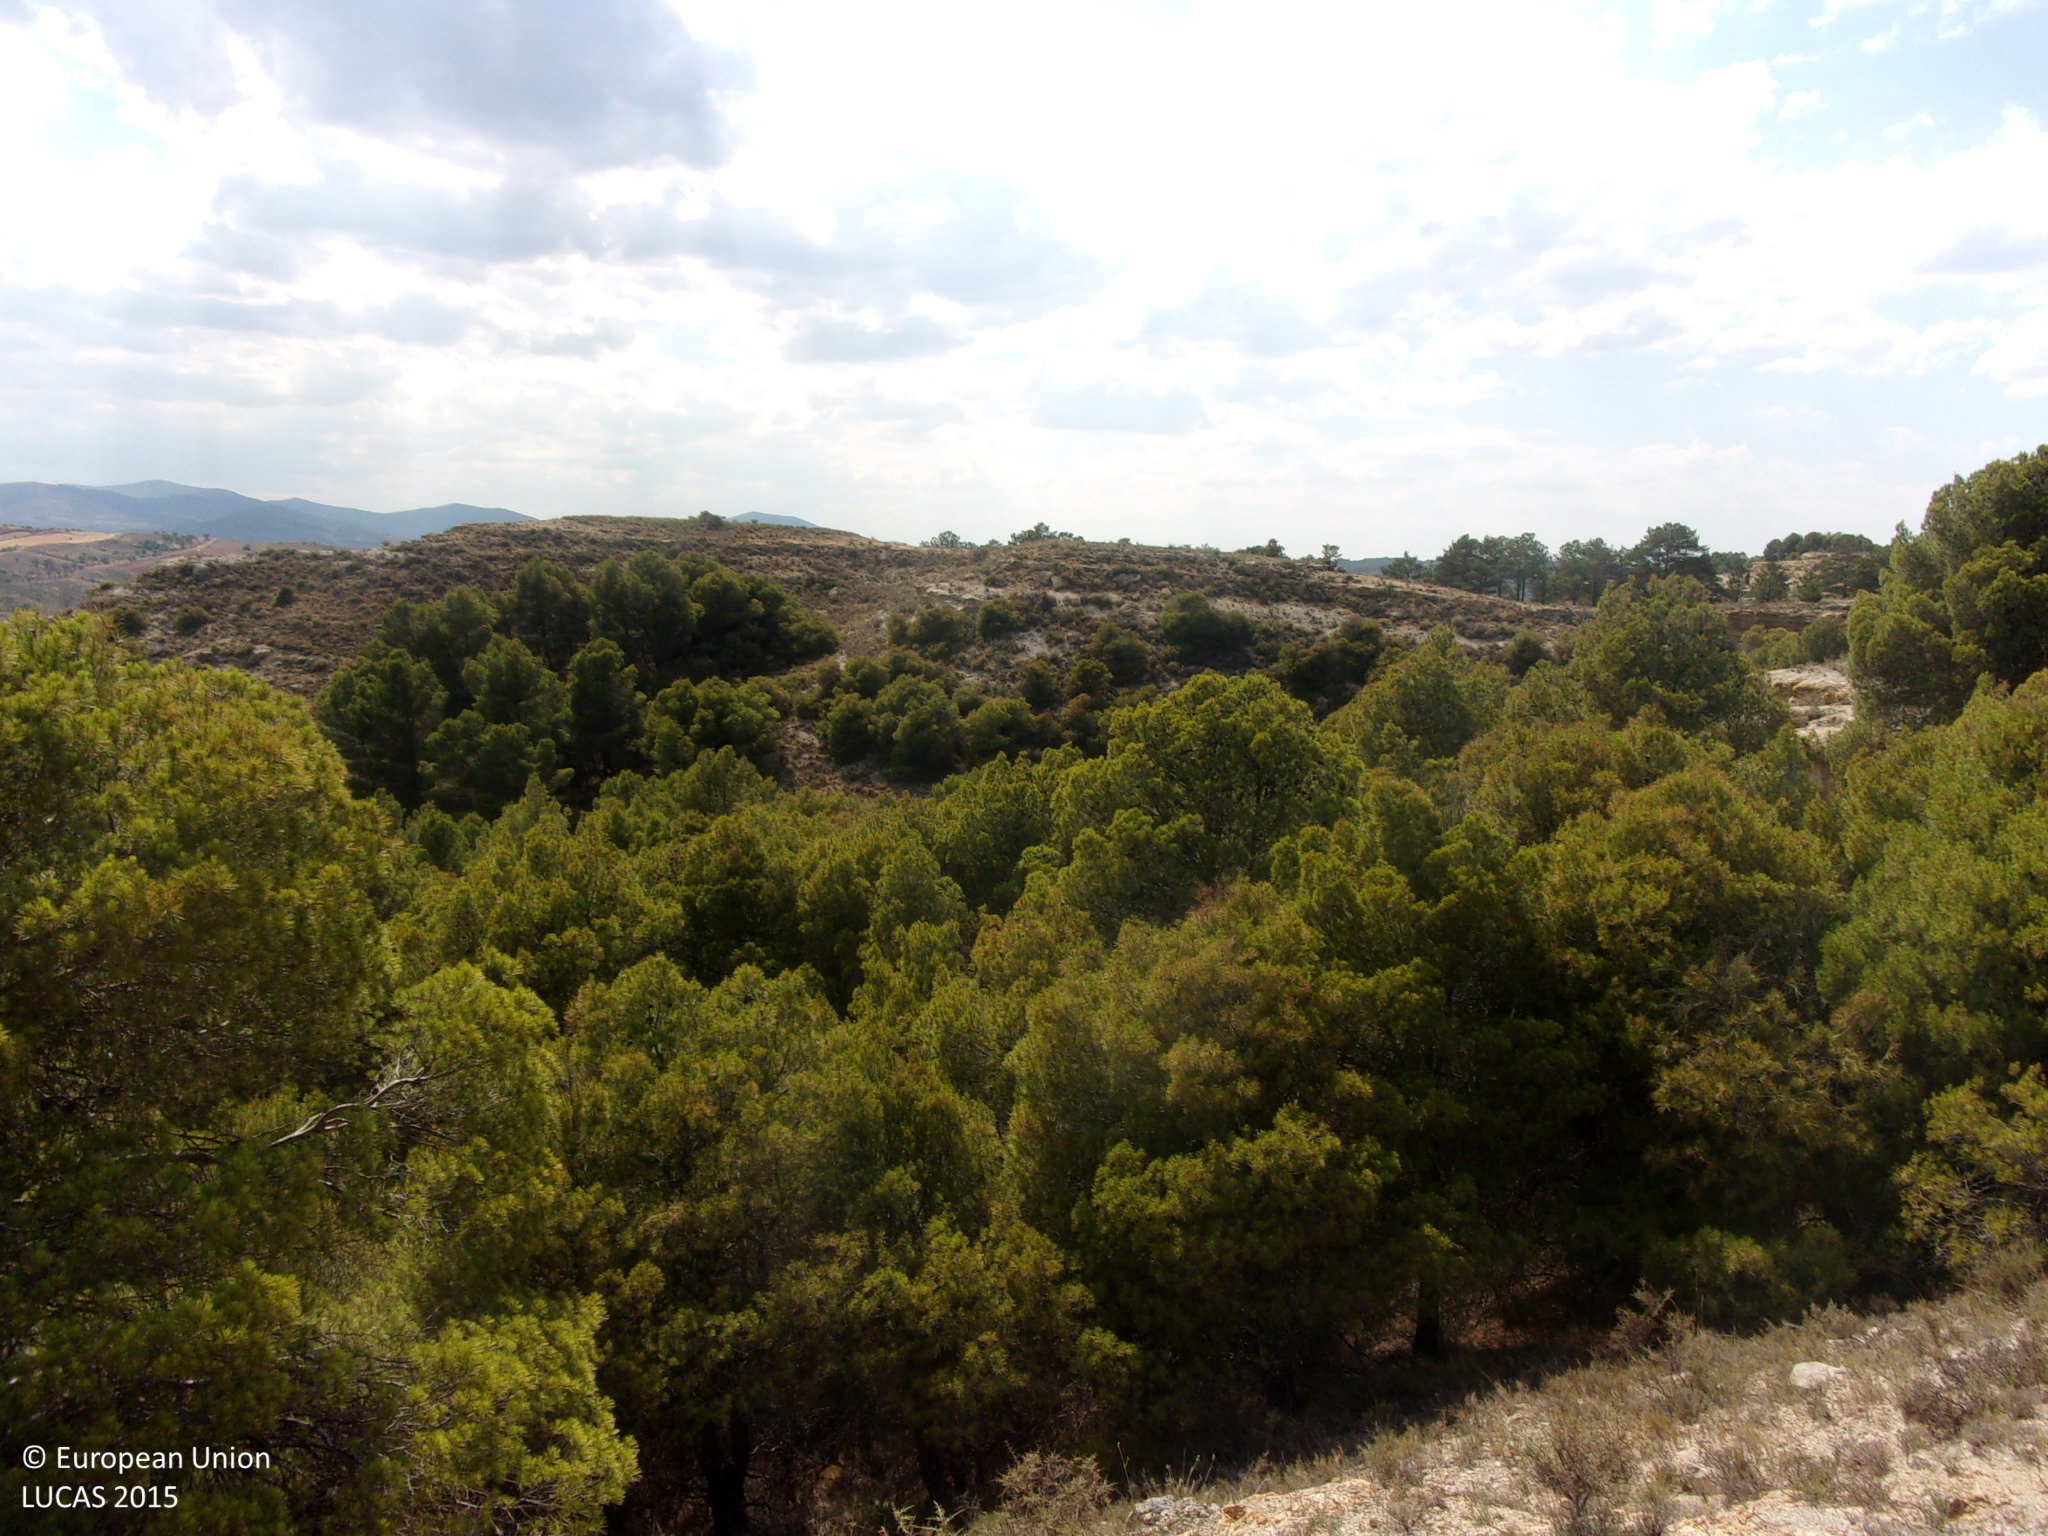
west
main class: Shrubland
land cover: Shrubland without tree cover
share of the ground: 50 - 75 %
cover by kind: shrubs 60 %, consolidated bare surface 30 %, herbaceous plants 10 %
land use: Semi-natural and natural areas not in use
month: July
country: ES
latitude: 41.1184
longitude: -1.3706
